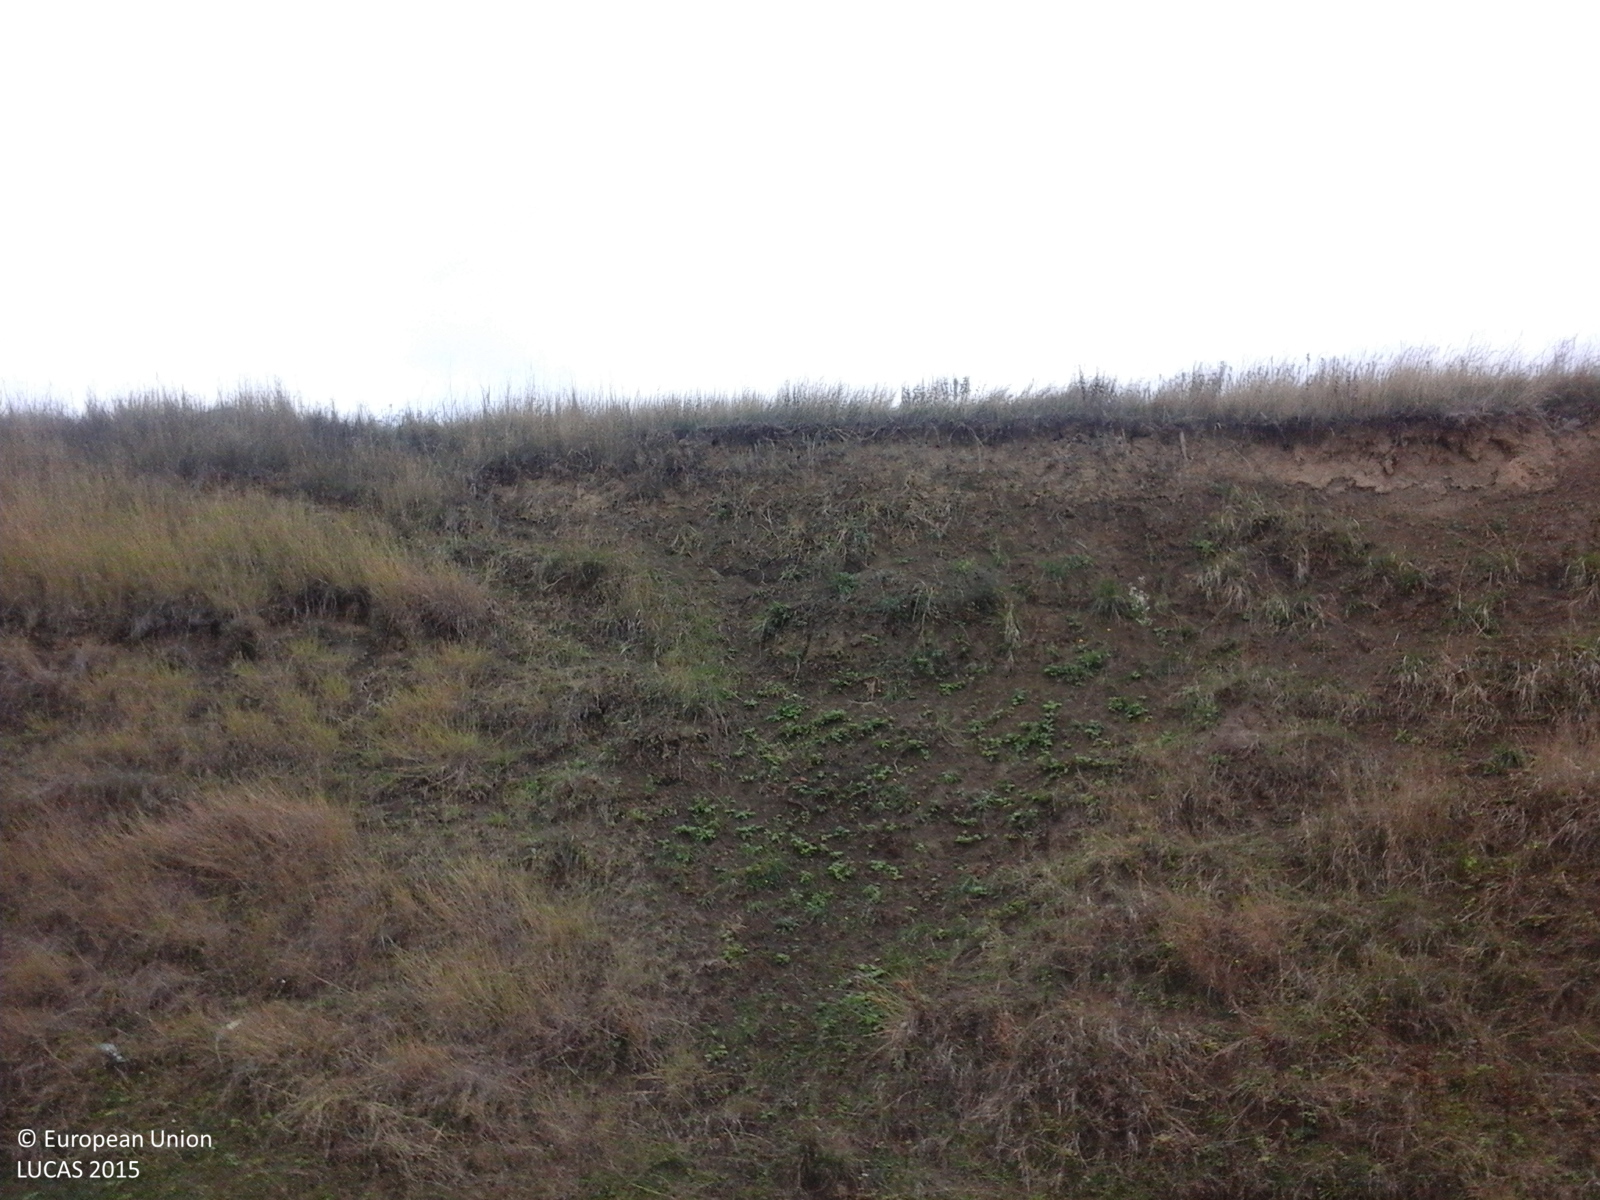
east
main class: Grassland
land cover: Spontaneously vegetated surfaces
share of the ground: > 75 %
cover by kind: herbaceous plants 100 %
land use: Semi-natural and natural areas not in use
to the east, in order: Spontaneously vegetated surfaces; Ditches and canals; Grassland without tree/shrub cover; Other bare soil
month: October
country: RO
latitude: 45.0096
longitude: 26.3448
